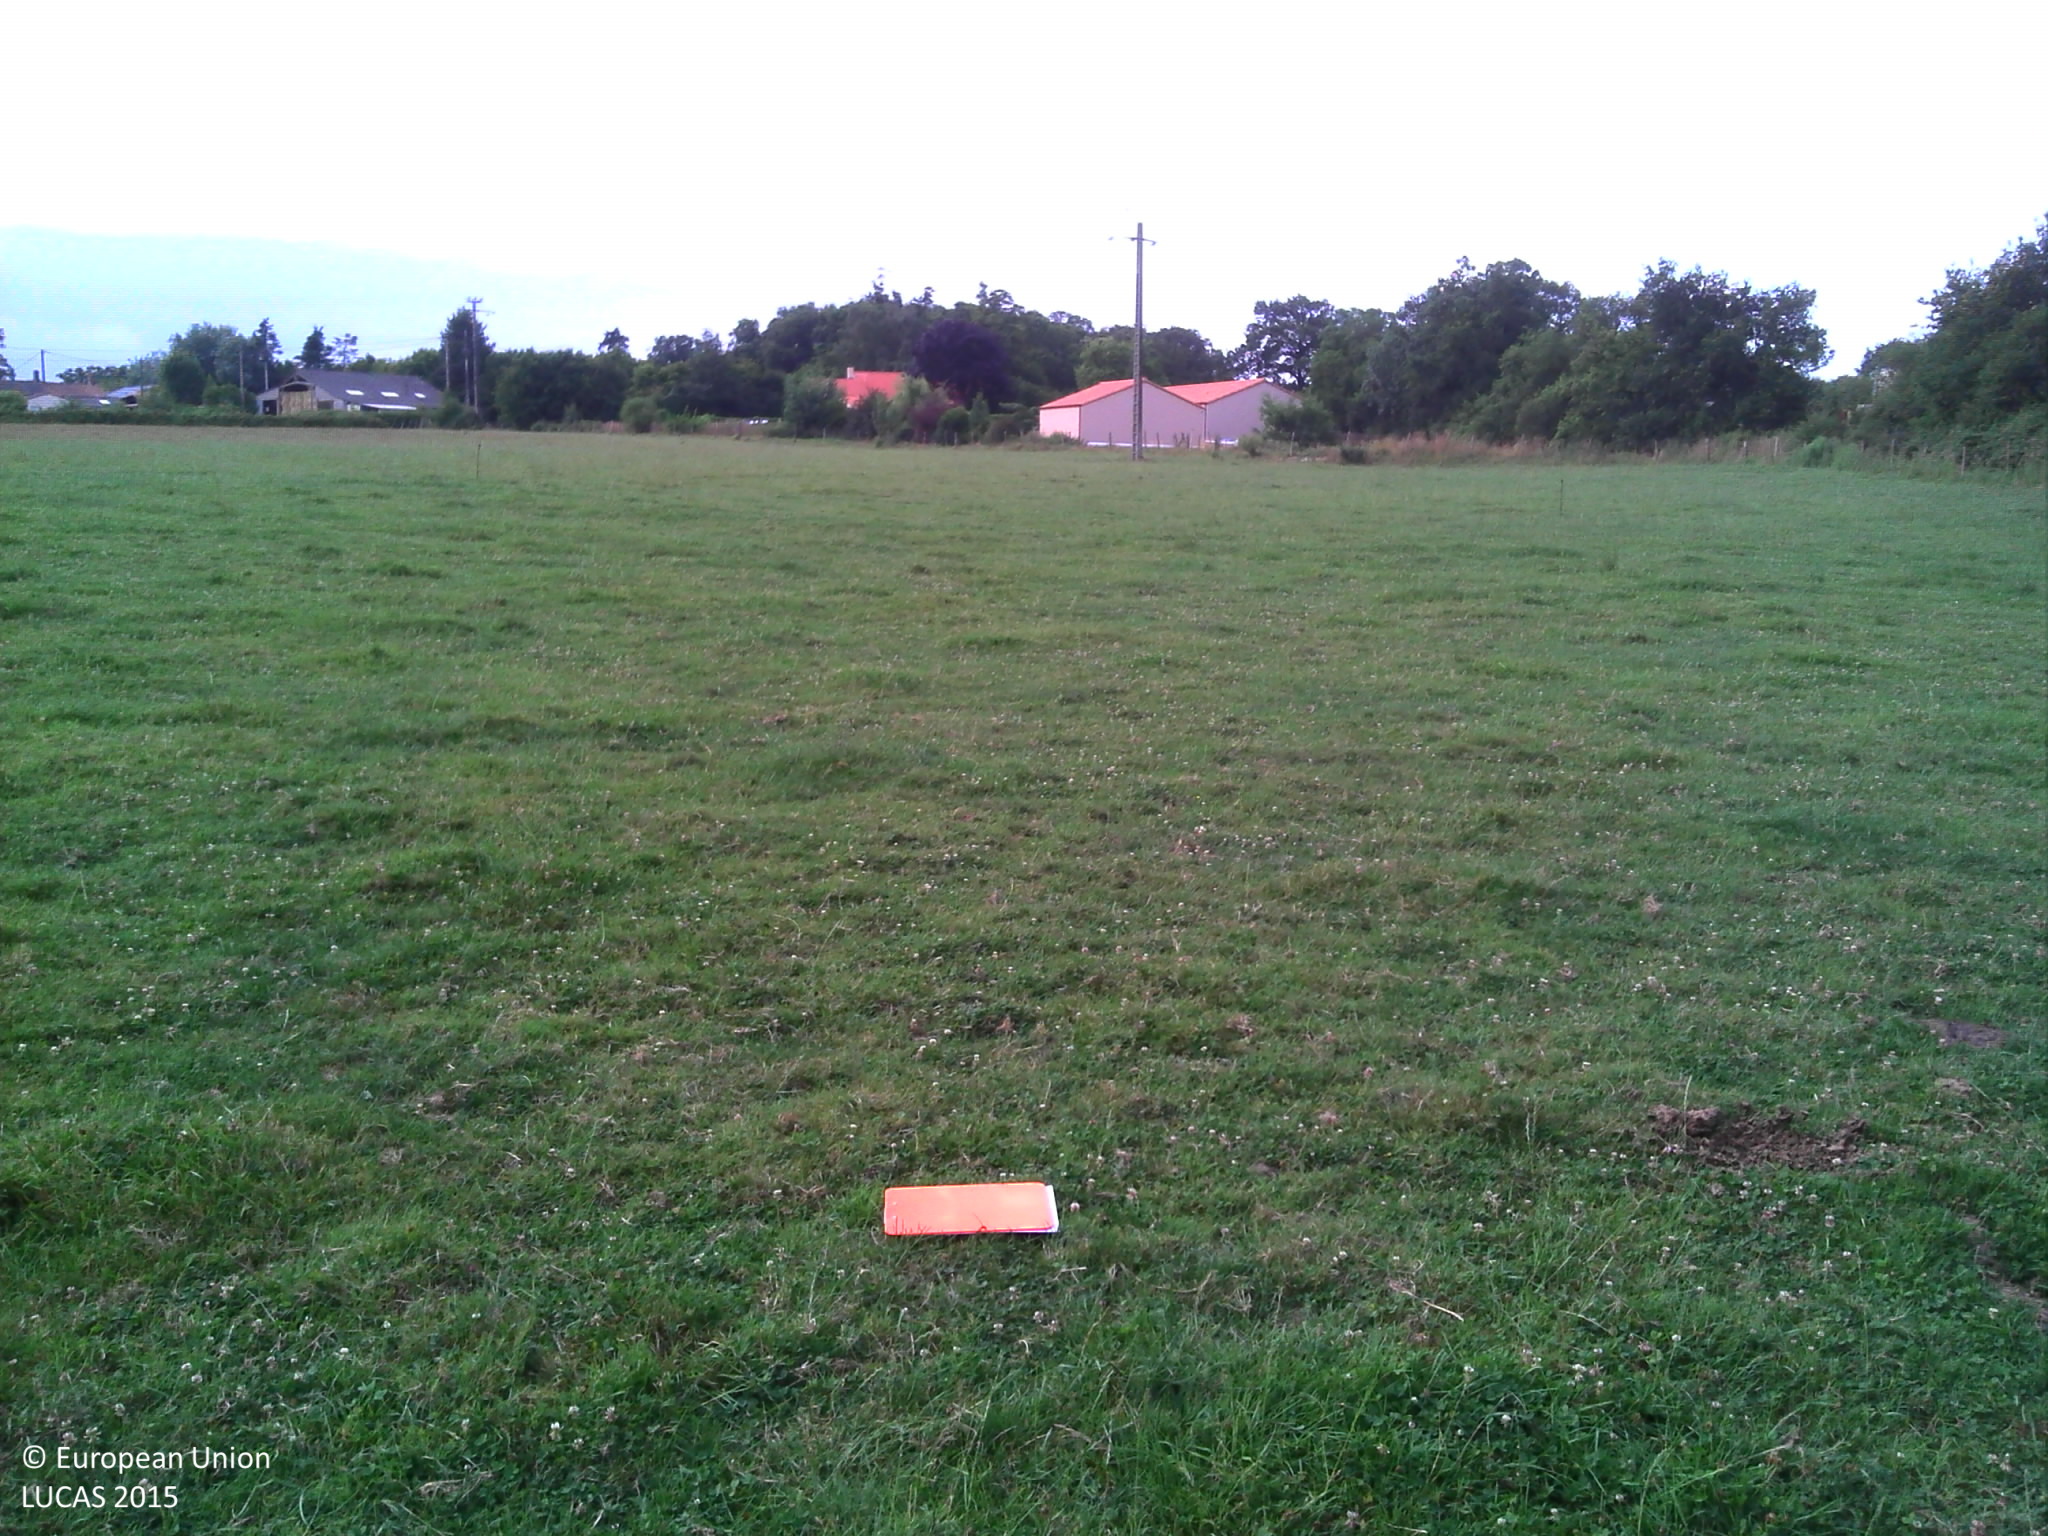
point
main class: Grassland
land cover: Grassland without tree/shrub cover
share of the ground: > 75 %
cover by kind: herbaceous plants 100 %
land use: Agriculture (excluding fallow land and kitchen gardens)
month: July
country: FR
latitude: 47.0746
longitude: -1.8317
